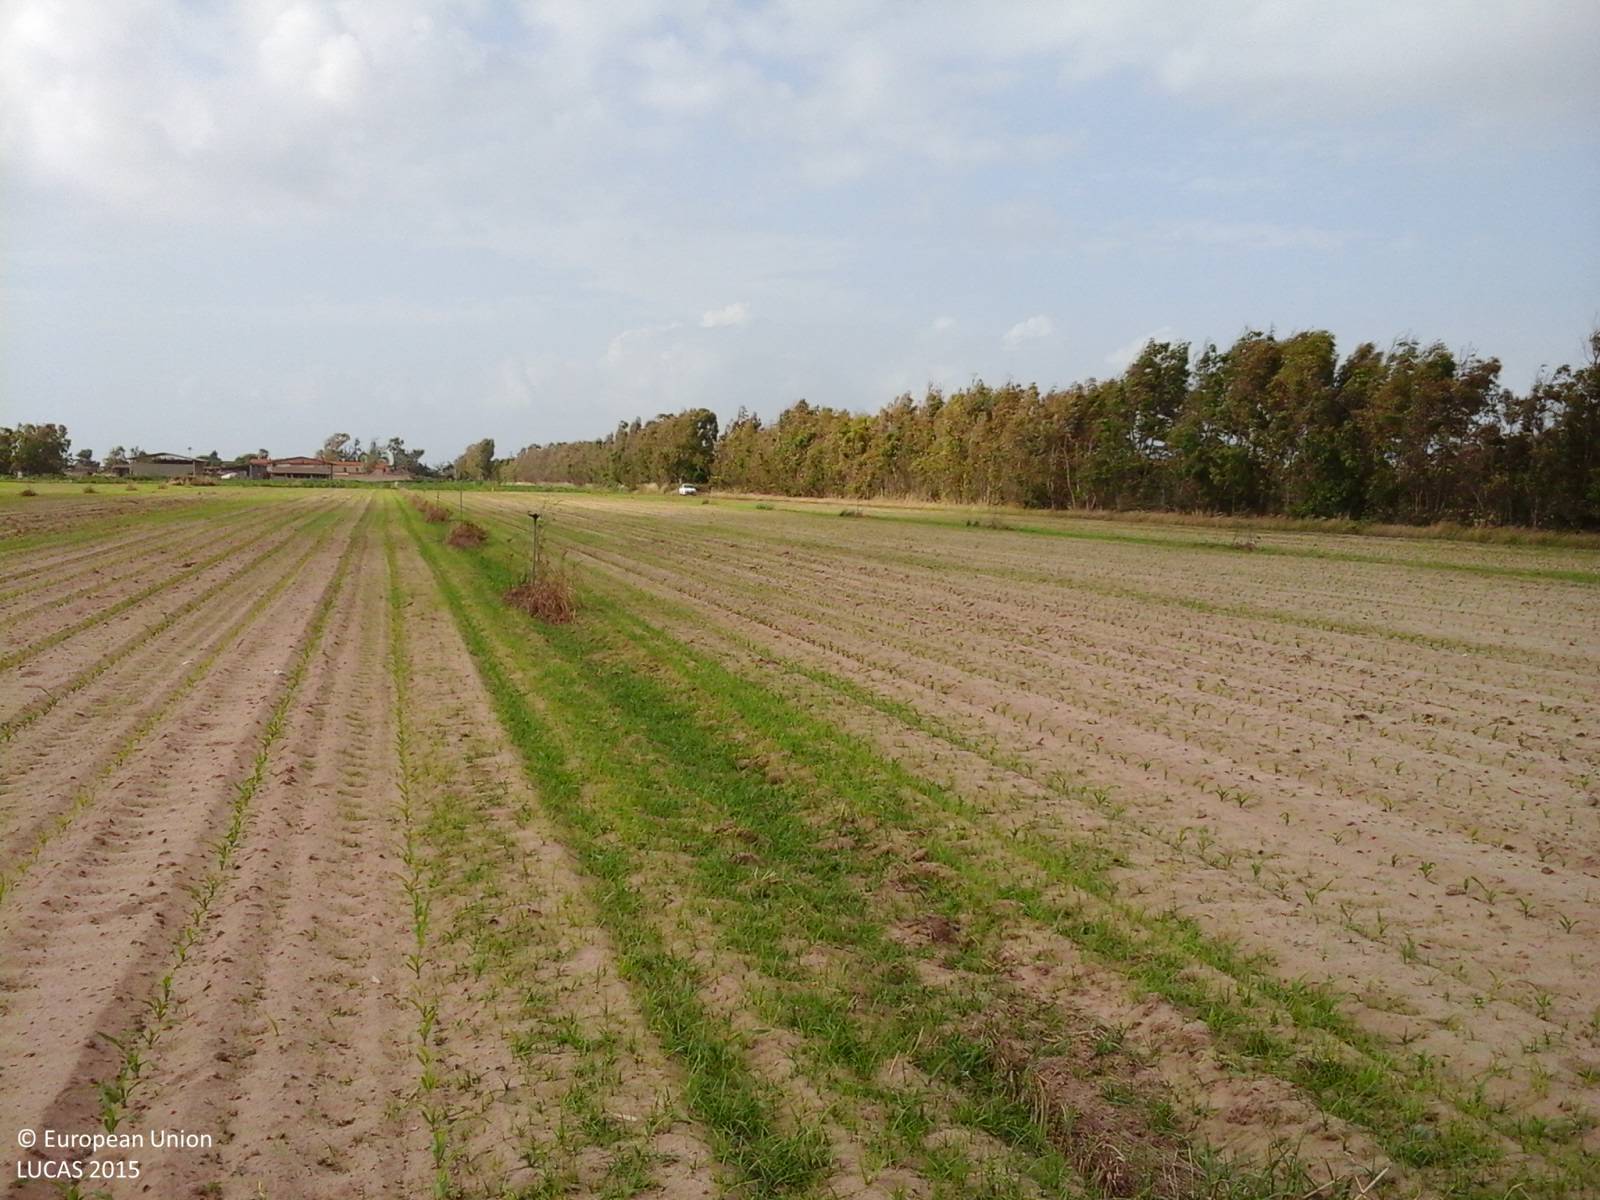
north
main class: Cropland
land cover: Maize
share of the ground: < 10 %
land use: Agriculture (excluding fallow land and kitchen gardens)
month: May
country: IT
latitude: 39.7311
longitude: 8.5266
